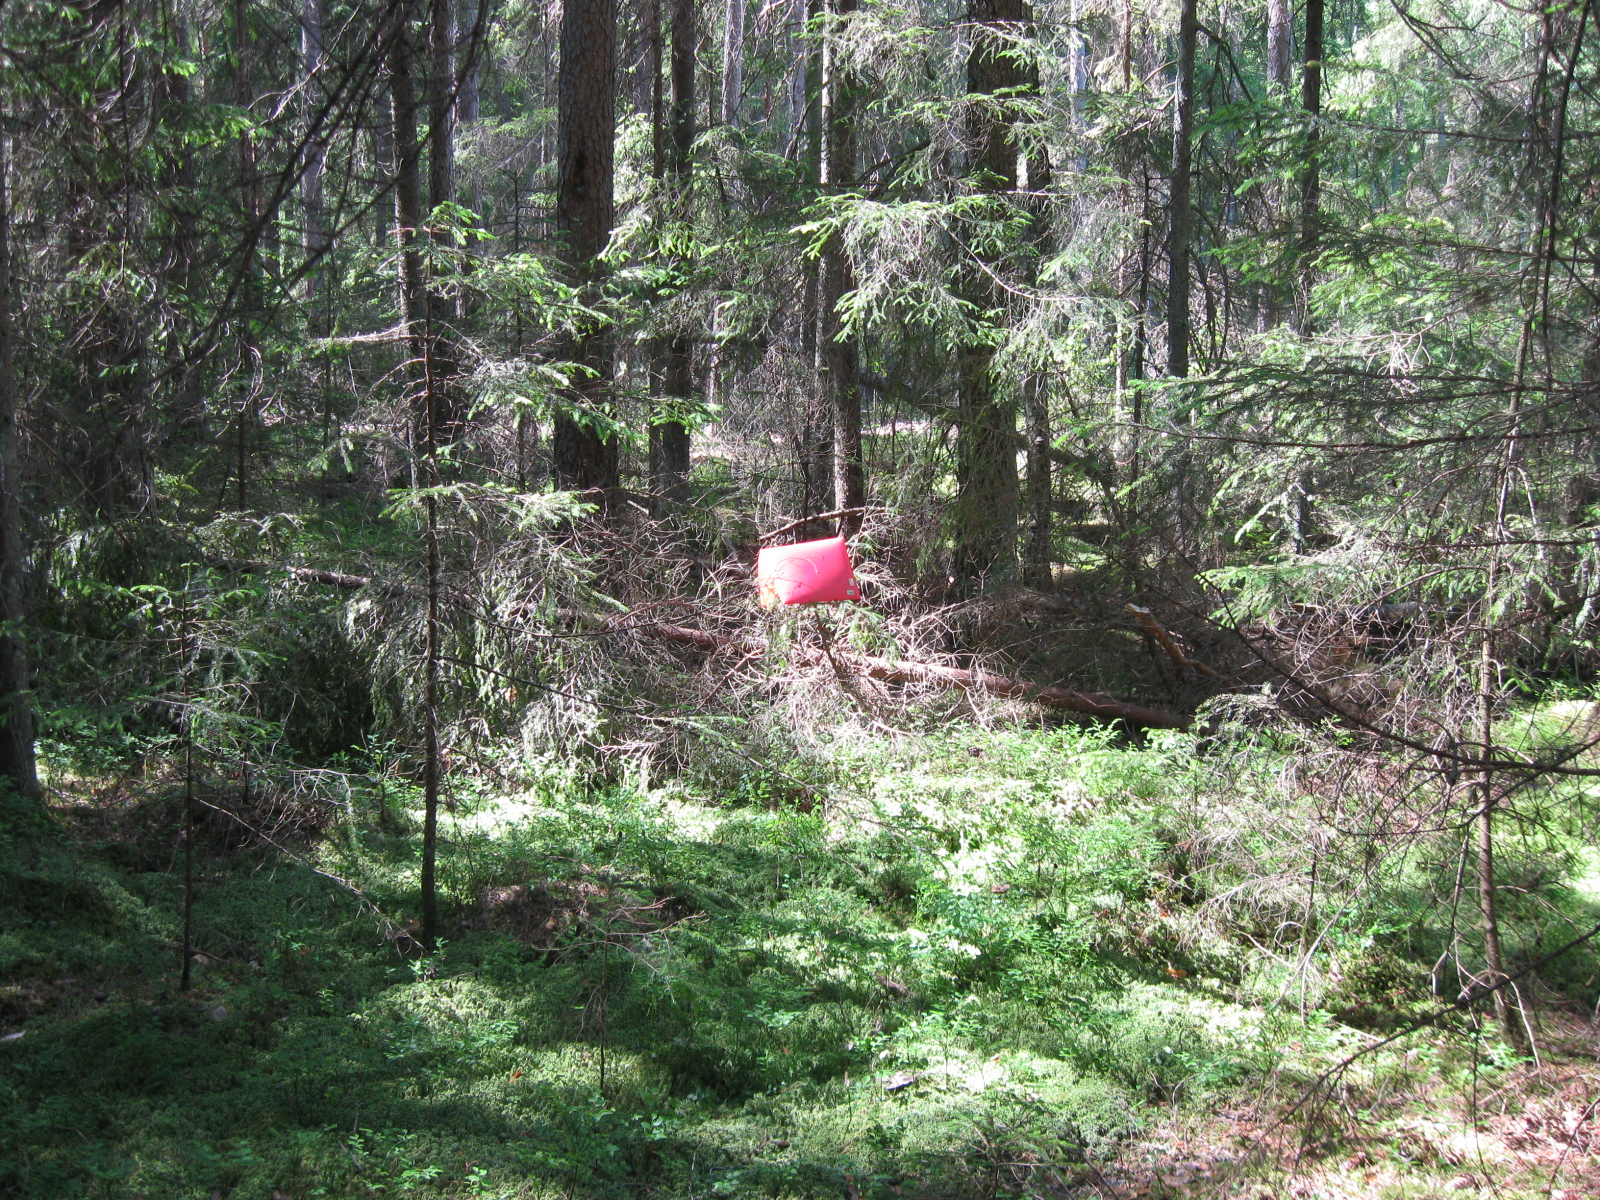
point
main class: Woodland
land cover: Other coniferous woodland
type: hemiboreal forest and nemoral coniferous forest and mixed broadleaved-coniferous forest
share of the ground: > 75 %
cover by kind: coniferous forest trees 95 %, lichens and mosses 5 %
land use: Forestry
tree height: > 5 m
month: June
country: LT
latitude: 53.9912
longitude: 24.1436
